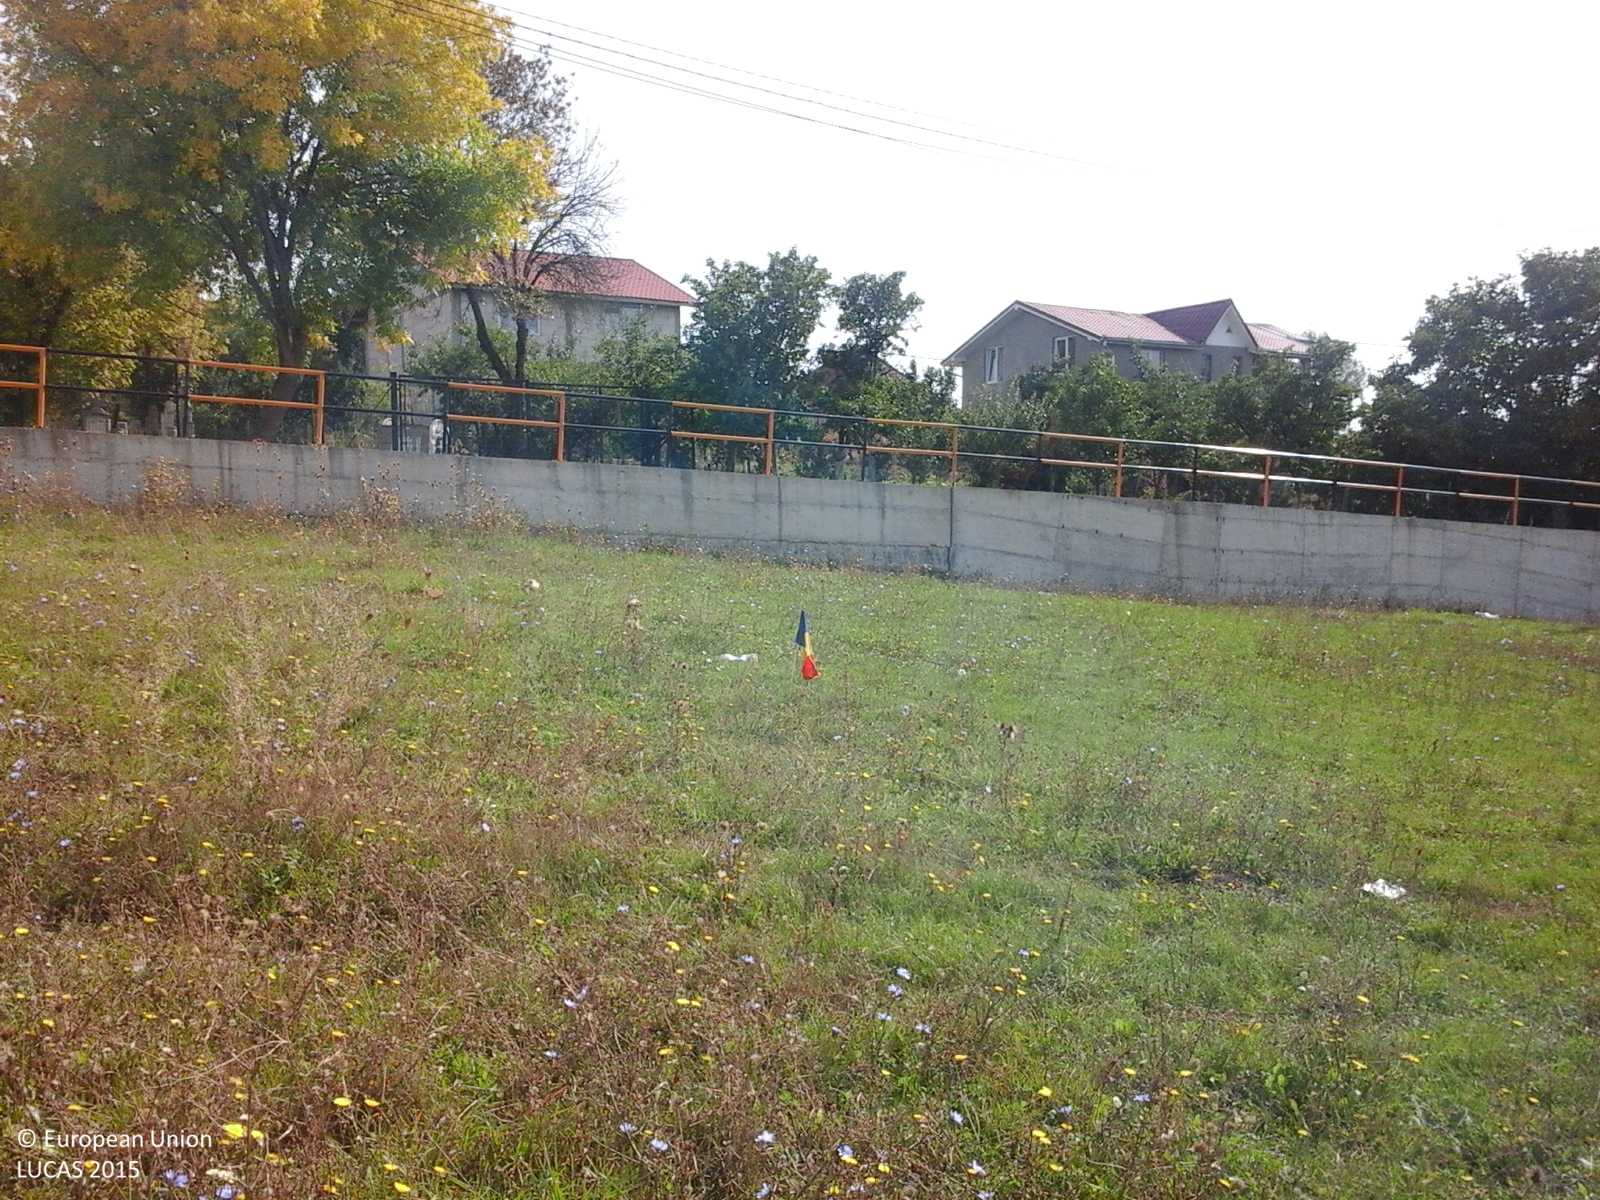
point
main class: Grassland
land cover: Grassland without tree/shrub cover
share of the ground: > 75 %
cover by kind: herbaceous plants 100 %
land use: Agriculture (excluding fallow land and kitchen gardens)
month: September
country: RO
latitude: 46.8091
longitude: 23.6087
